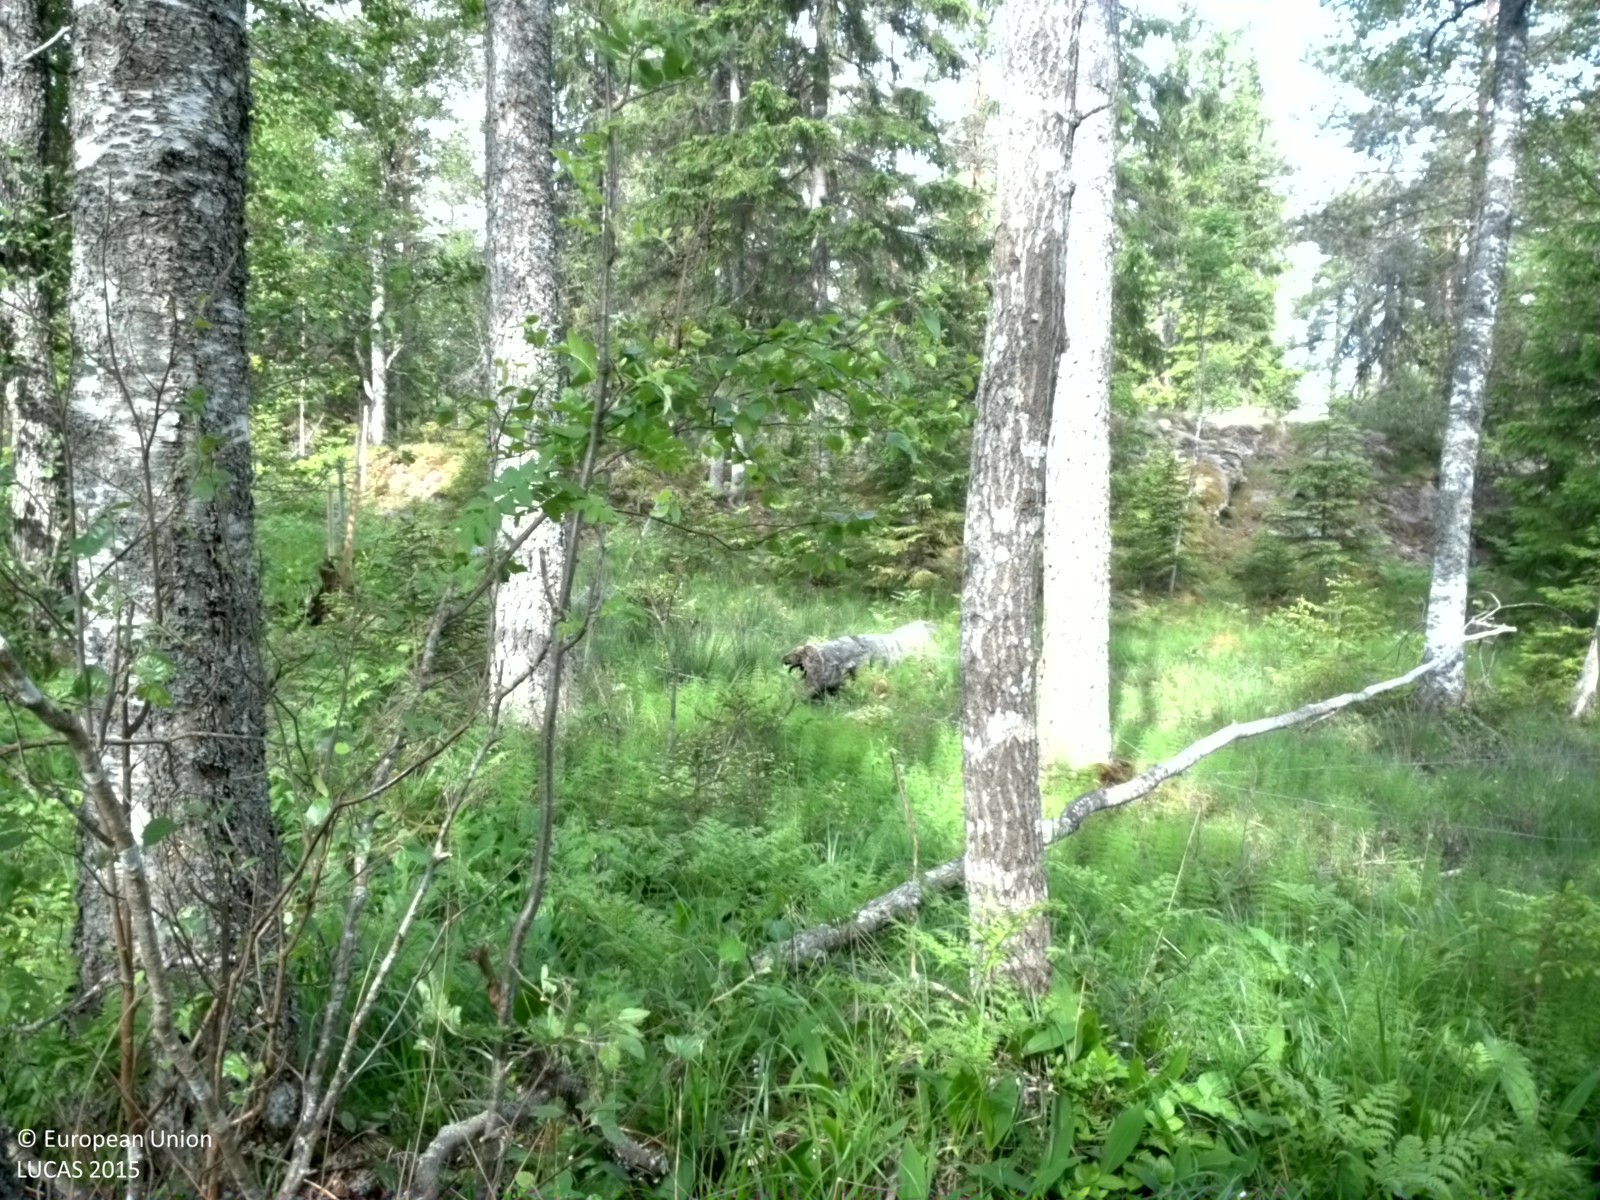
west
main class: Woodland
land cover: Spruce dominated mixed woodland
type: boreal forest
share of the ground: 50 - 75 %
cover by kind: herbaceous plants 35 %, coniferous forest trees 30 %, broadleaved forest trees 30 %, shrubs 5 %
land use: Forestry
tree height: > 5 m
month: June
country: SE
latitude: 60.3326
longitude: 18.0174
